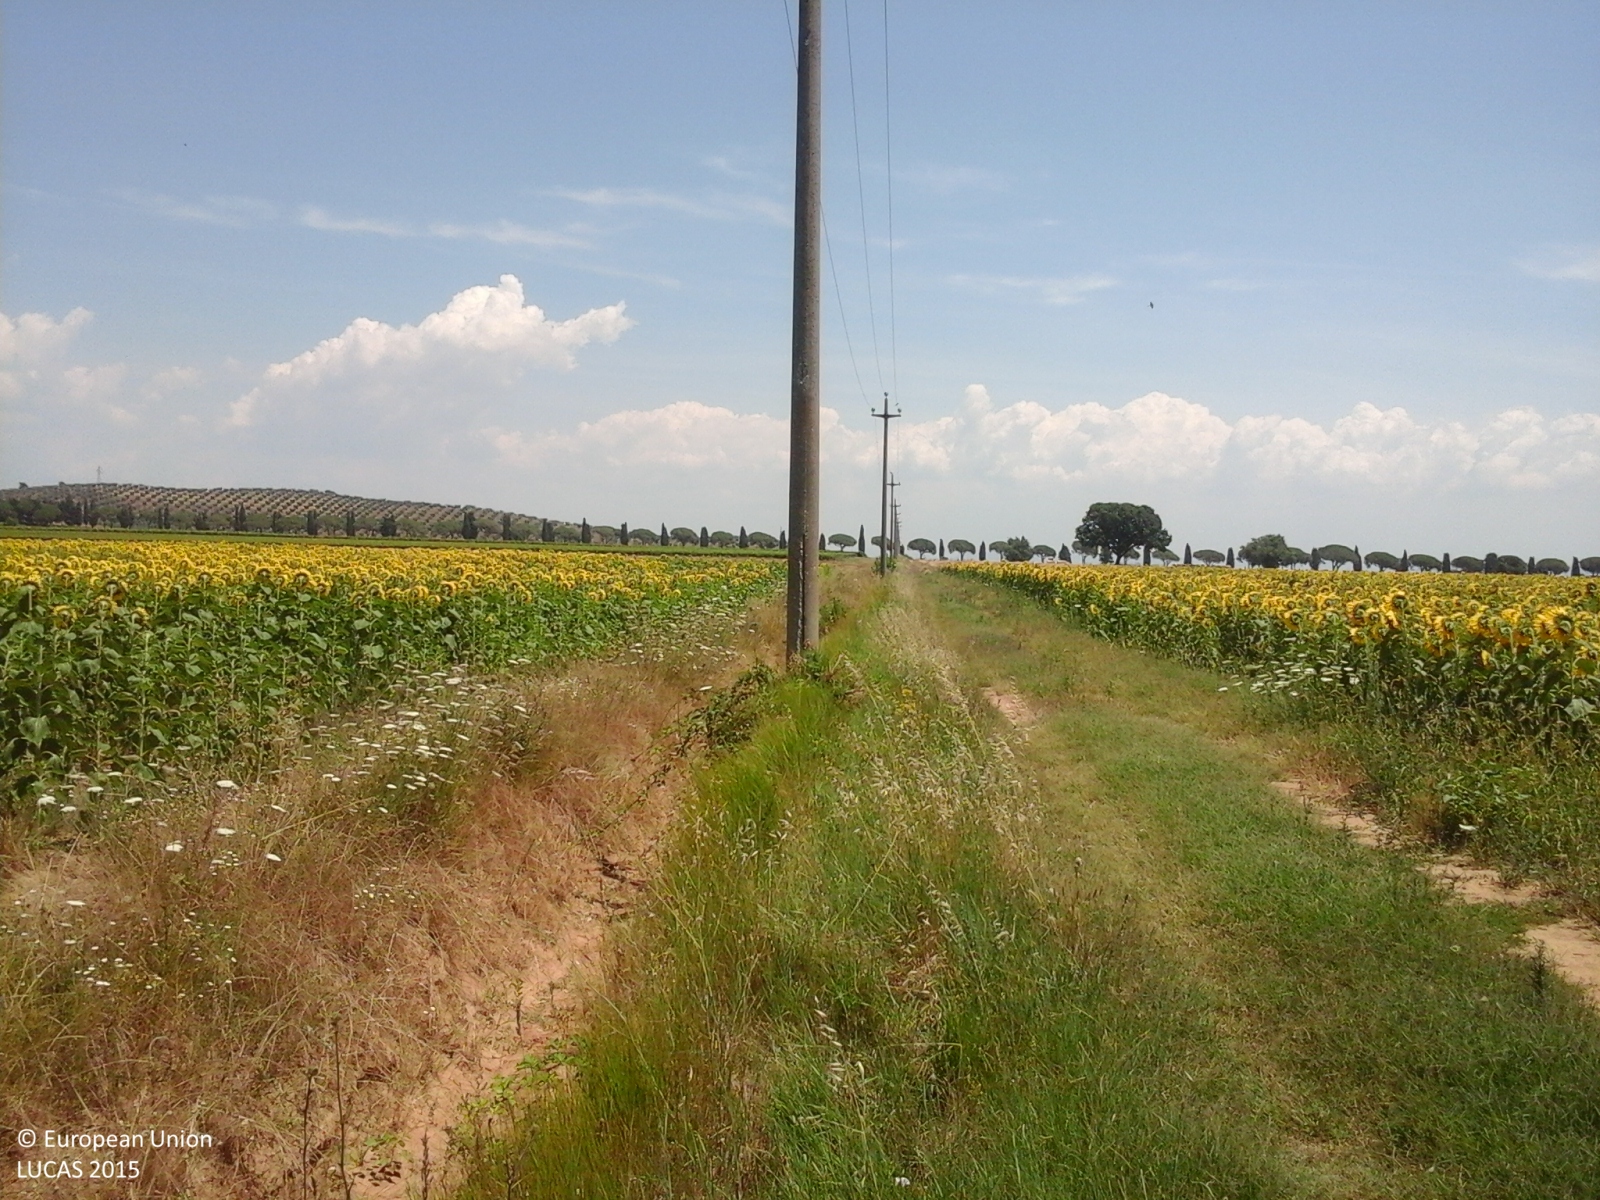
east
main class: Cropland
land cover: Sunflower
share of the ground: > 75 %
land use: Agriculture (excluding fallow land and kitchen gardens)
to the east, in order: Sunflower; Ditches and canals; Sunflower; Ditches and canals; Sunflower; Ditches and canals; Common wheat; Ditches and canals; Sunflower
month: June
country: IT
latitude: 42.7939
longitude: 10.9627
